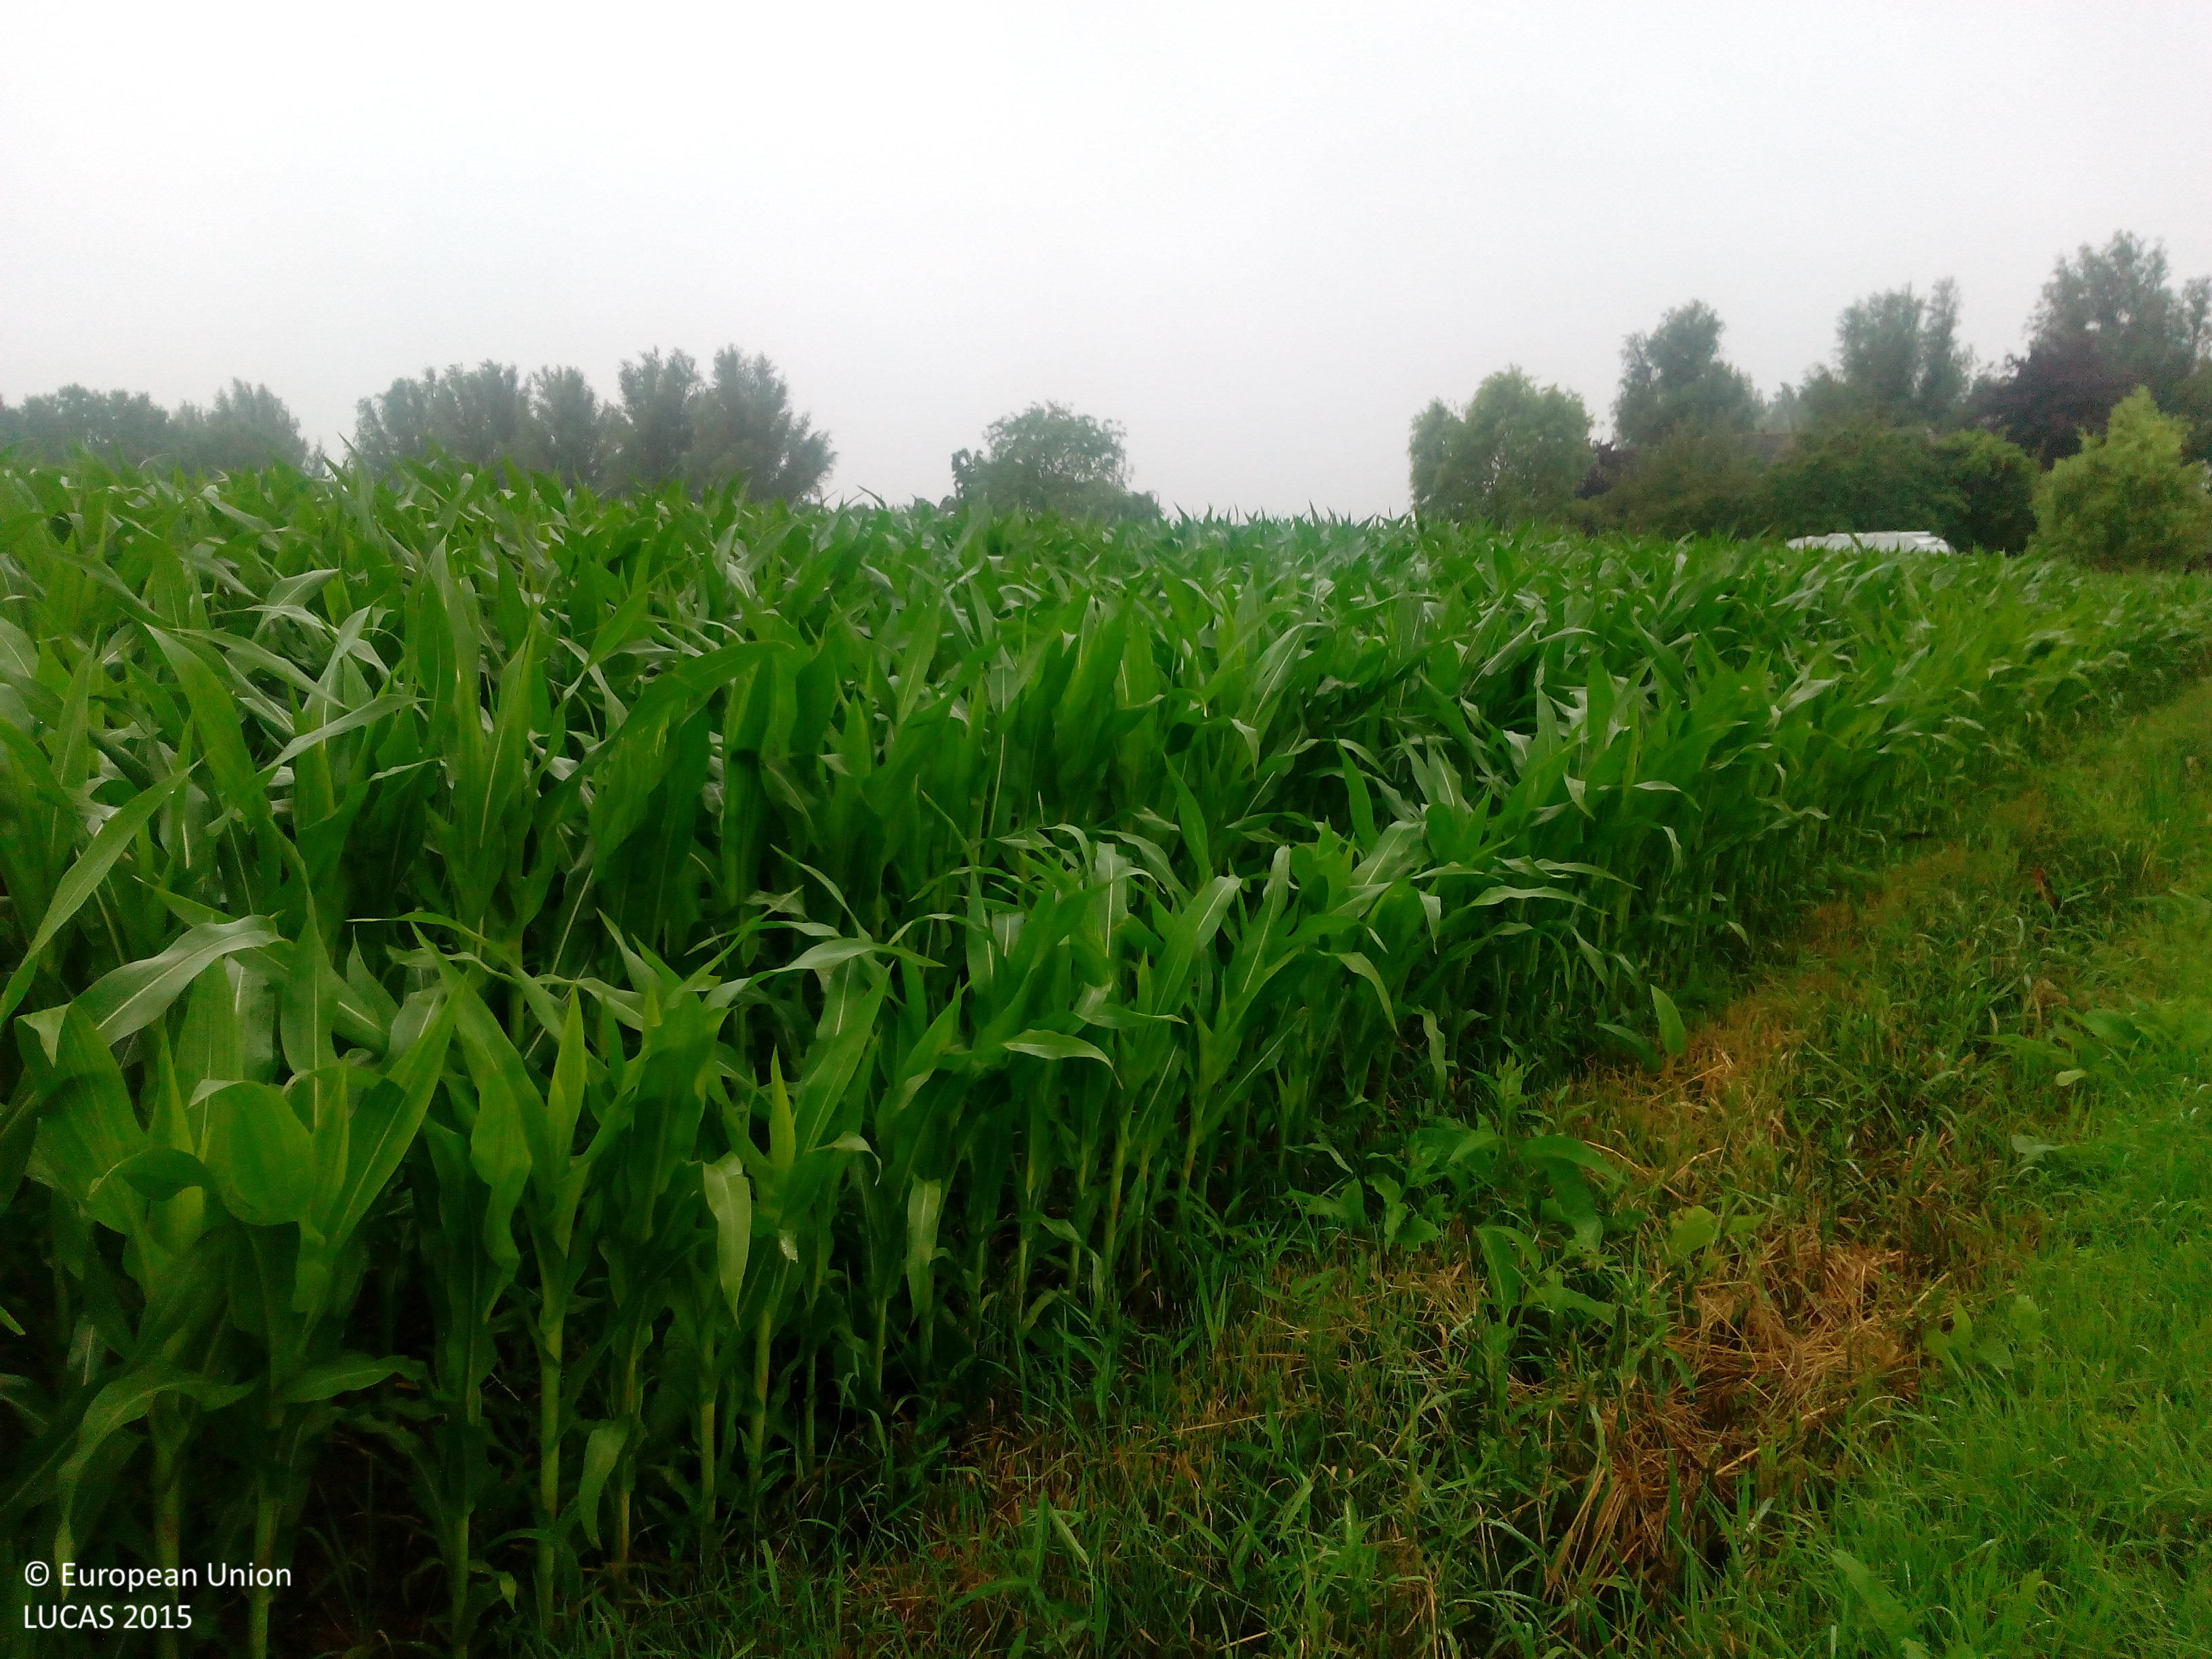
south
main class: Cropland
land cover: Maize
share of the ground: > 75 %
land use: Agriculture (excluding fallow land and kitchen gardens)
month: July
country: NL
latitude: 51.9955
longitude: 6.2855
